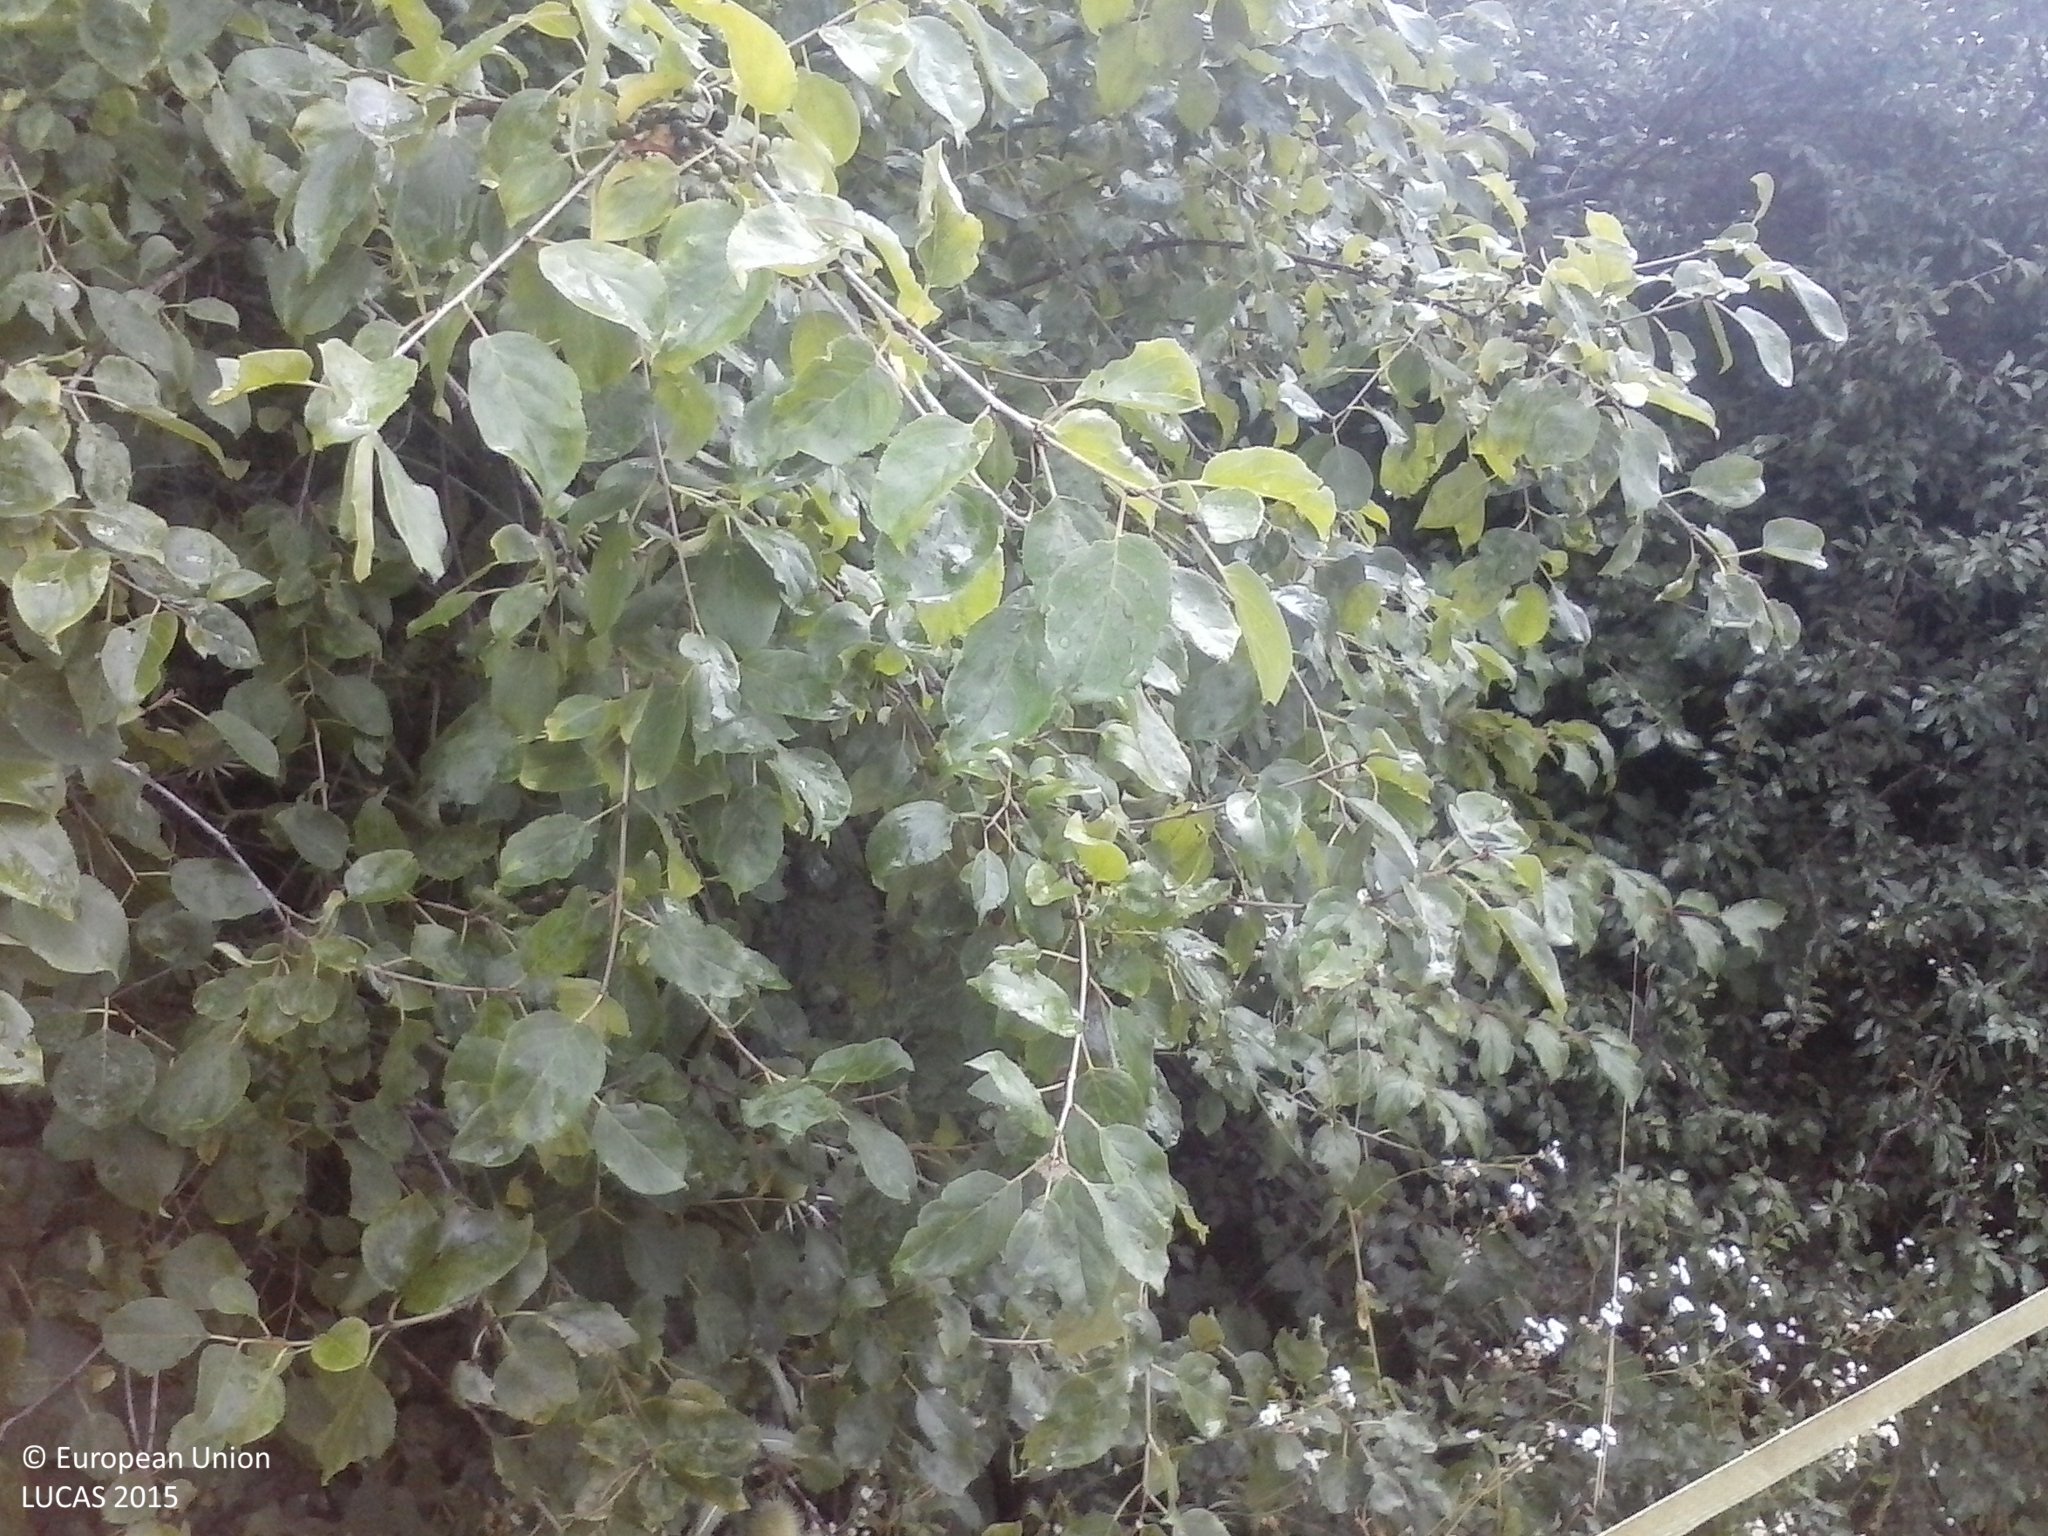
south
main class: Shrubland
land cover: Shrubland with sparse tree cover
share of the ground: > 75 %
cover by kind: shrubs 90 %, broadleaved forest trees 5 %, herbaceous plants 5 %
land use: Agriculture (excluding fallow land and kitchen gardens)
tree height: > 5 m
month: July
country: HU
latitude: 46.0359
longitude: 17.7181
